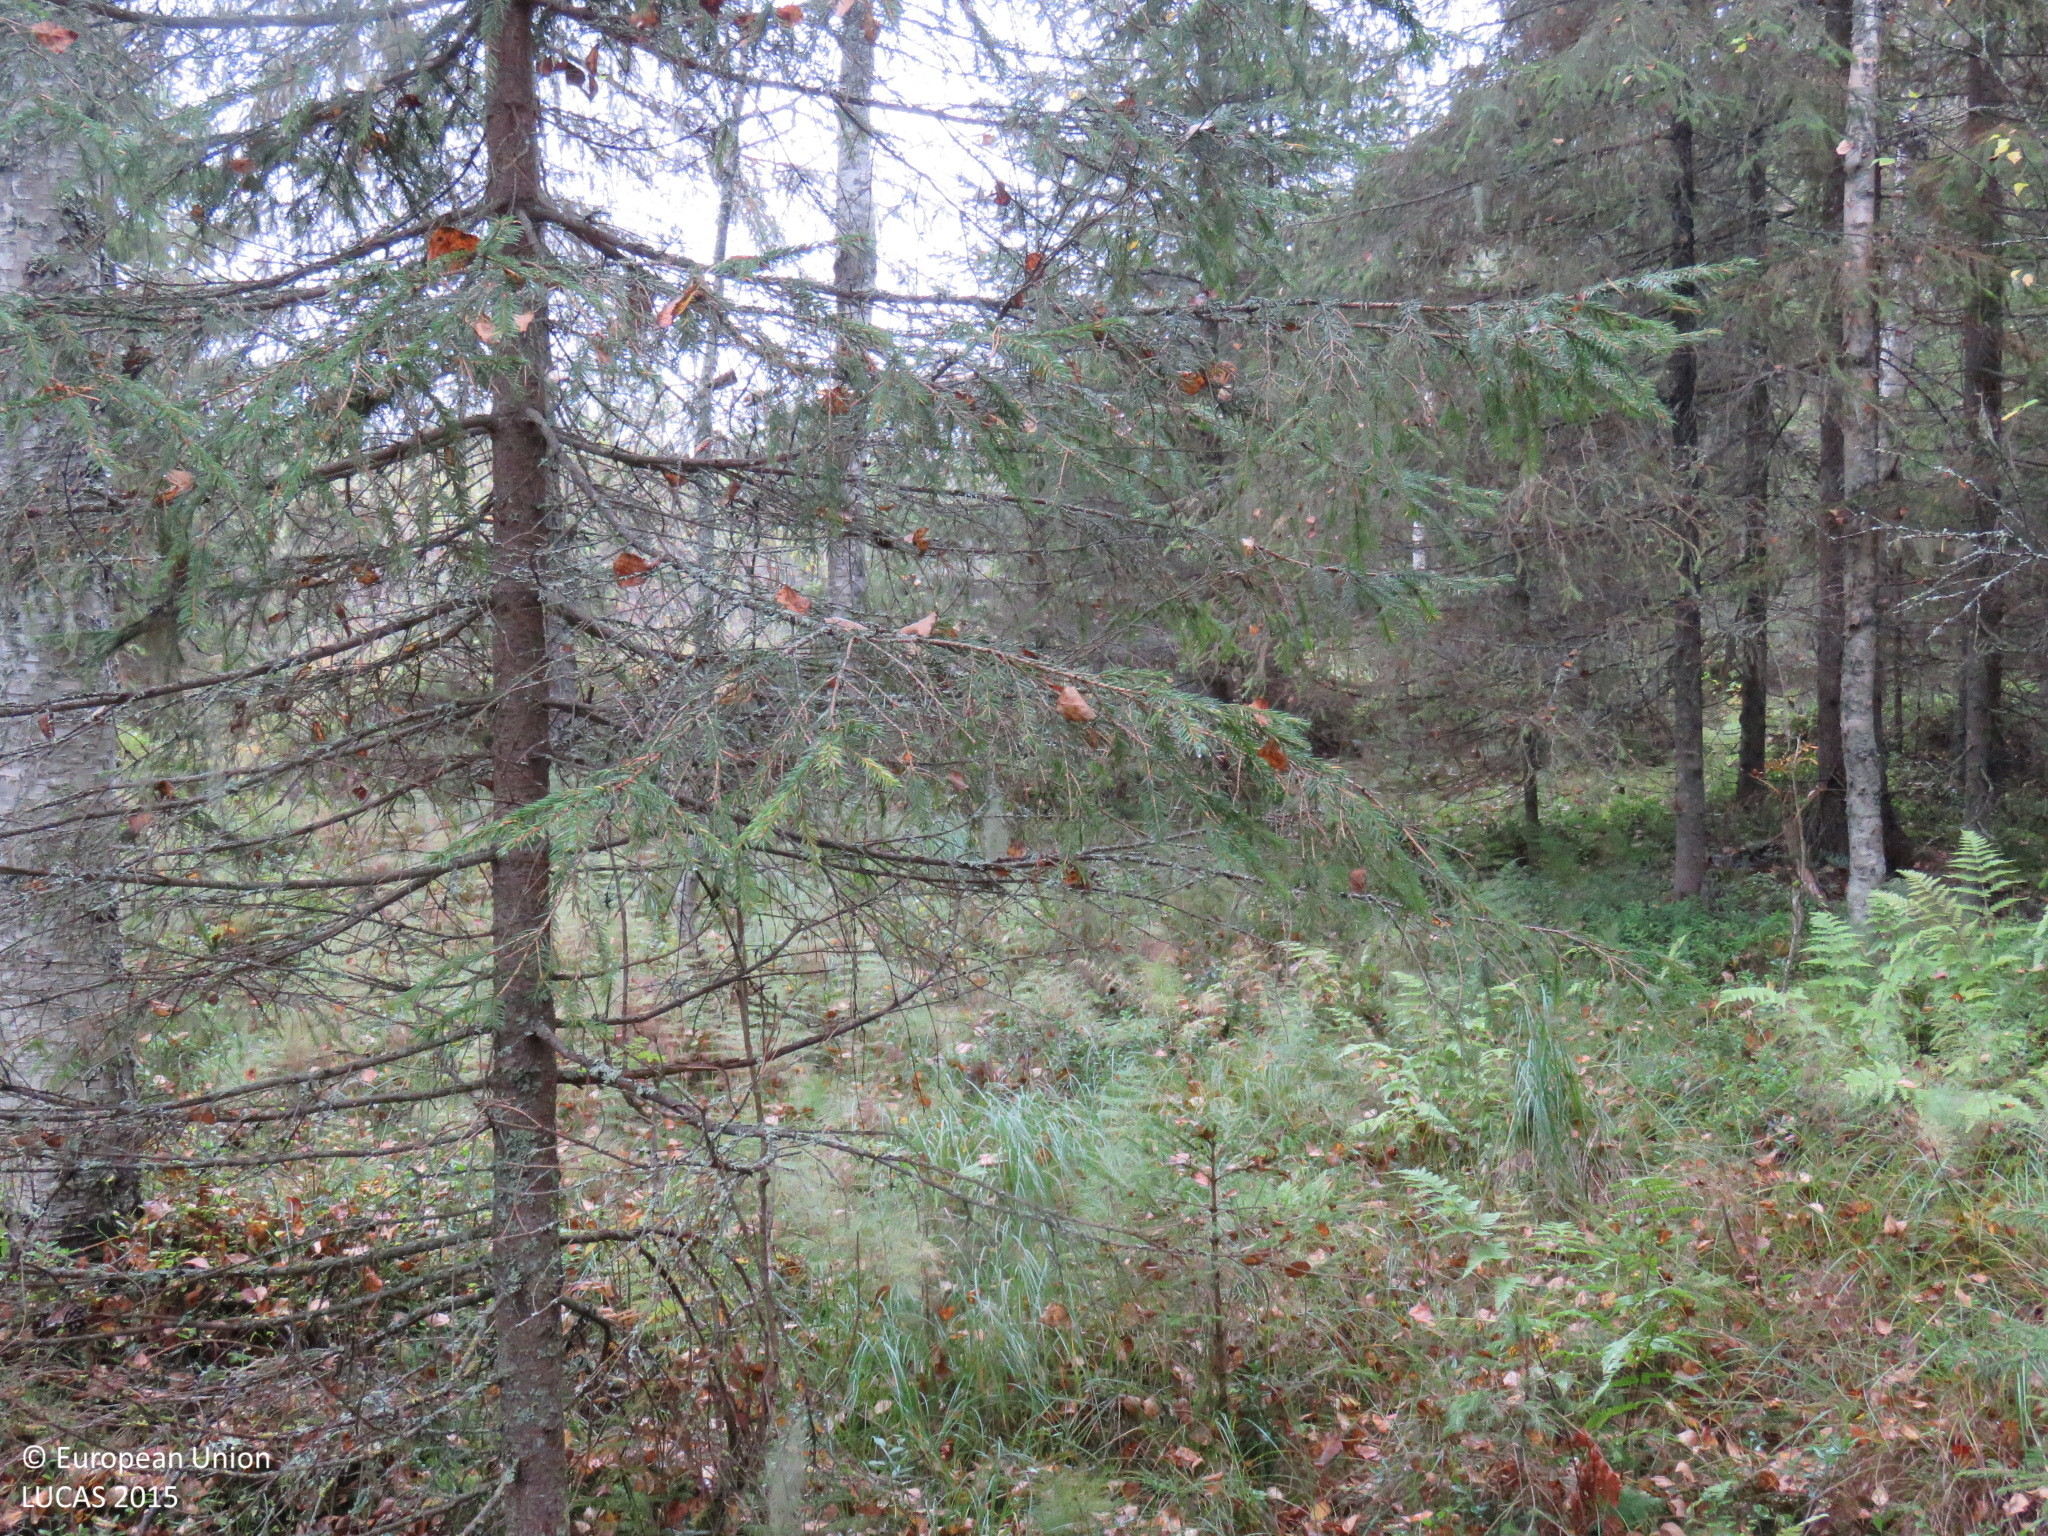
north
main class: Woodland
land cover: Other mixed woodland
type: boreal forest
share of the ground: > 75 %
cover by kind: coniferous forest trees 65 %, broadleaved forest trees 25 %, shrubs 5 %, herbaceous plants 5 %
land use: Forestry
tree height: > 5 m
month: September
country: FI
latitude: 64.8785
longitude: 26.6867
